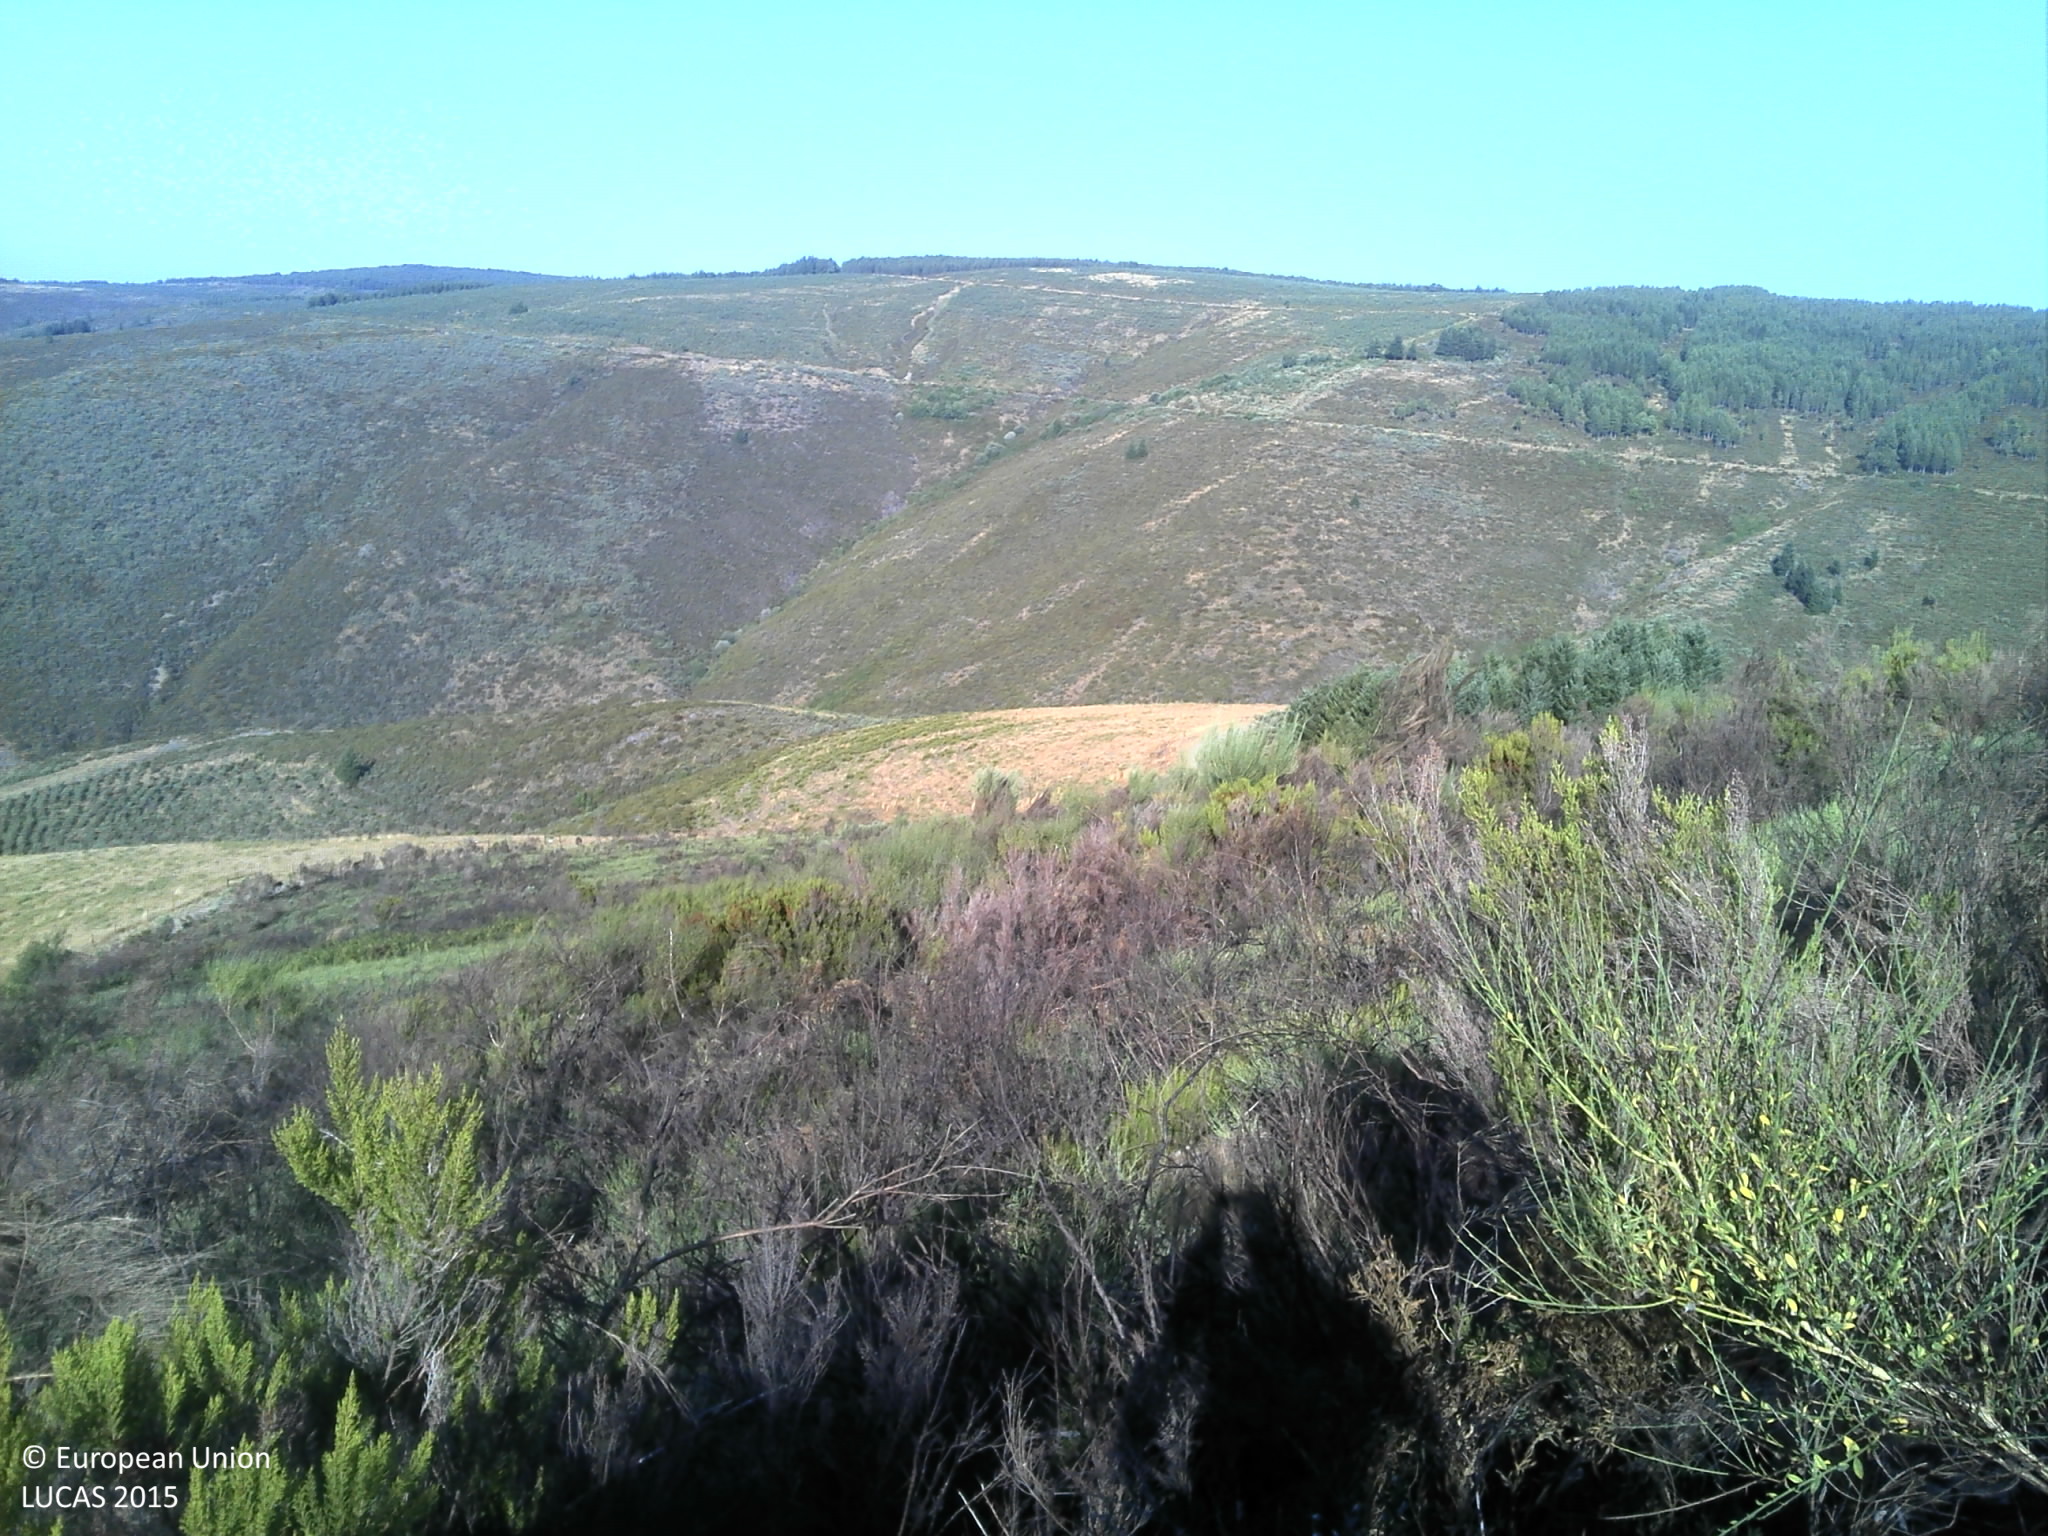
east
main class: Shrubland
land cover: Shrubland without tree cover
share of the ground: > 75 %
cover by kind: shrubs 90 %, unconsolidated bare surface 10 %
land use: Abandoned areas
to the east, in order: Shrubland without tree cover; Tracks; Shrubland without tree cover
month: July
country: PT
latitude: 40.4561
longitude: -7.4795
